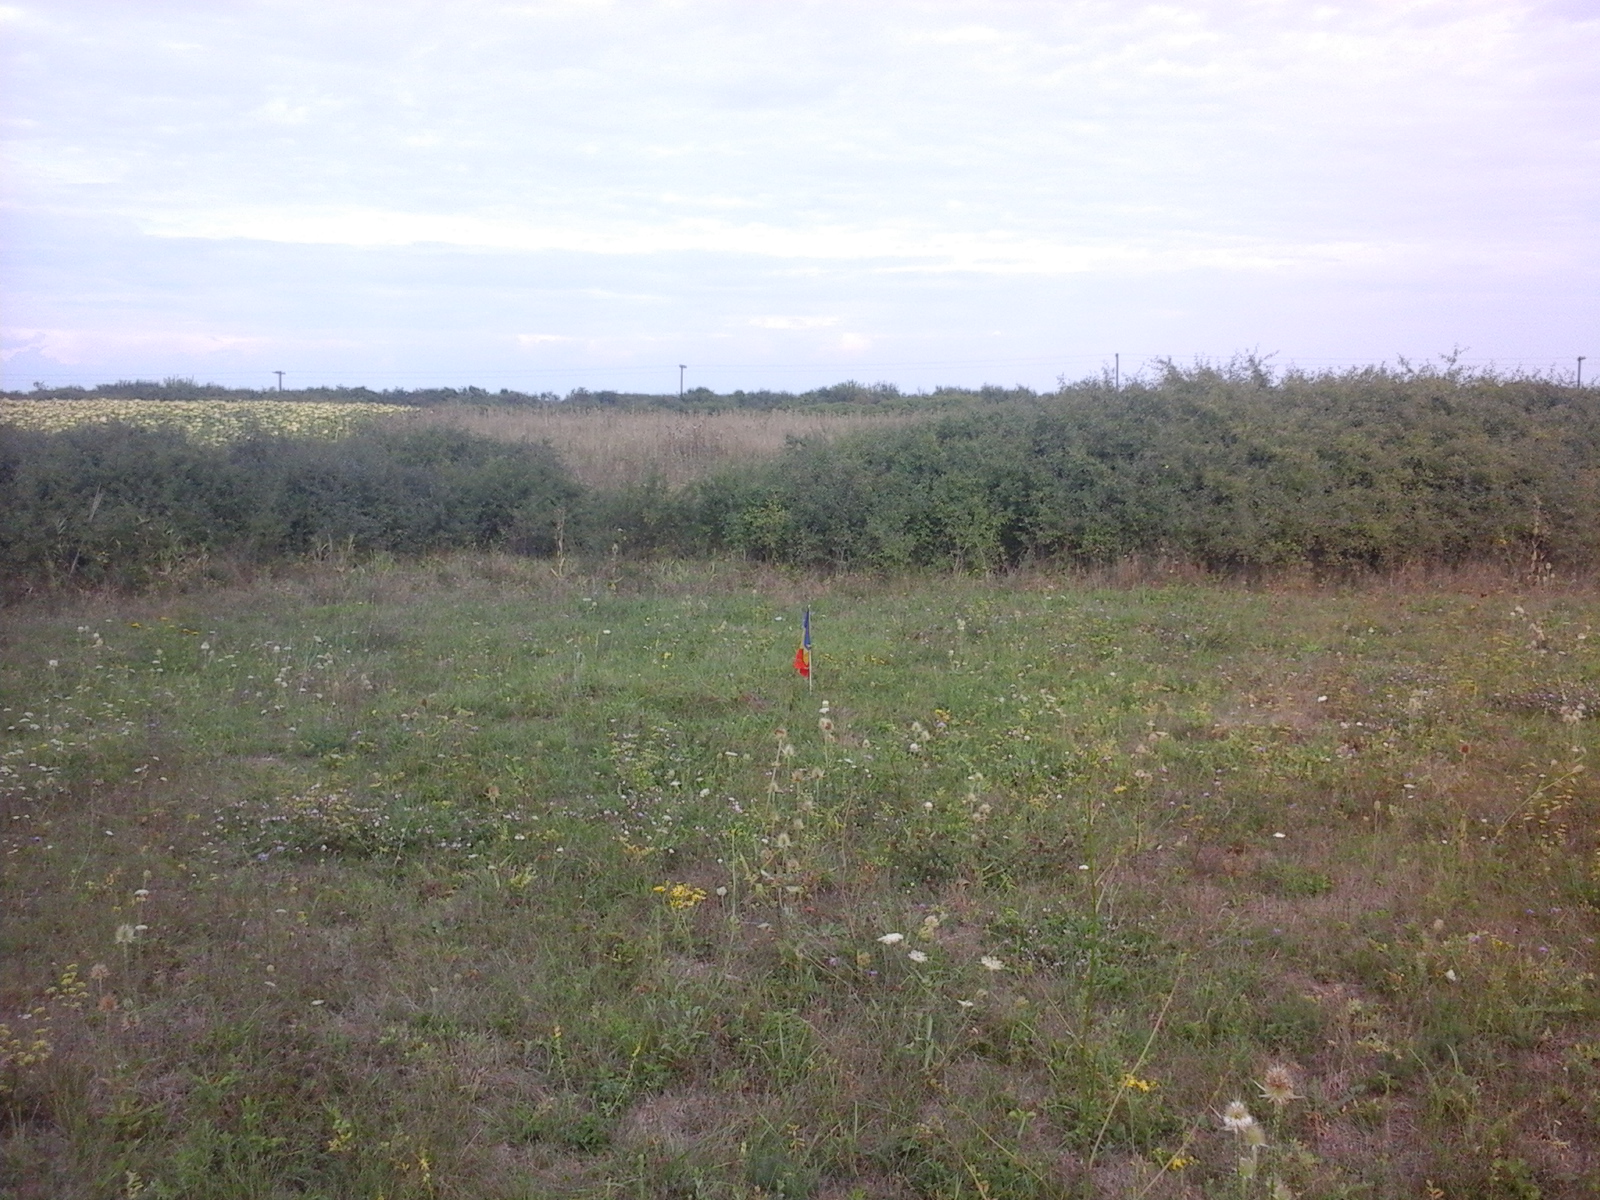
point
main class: Grassland
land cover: Grassland without tree/shrub cover
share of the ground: > 75 %
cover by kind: herbaceous plants 100 %
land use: Agriculture (excluding fallow land and kitchen gardens)
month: August
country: RO
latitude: 46.7366
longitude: 21.5961
